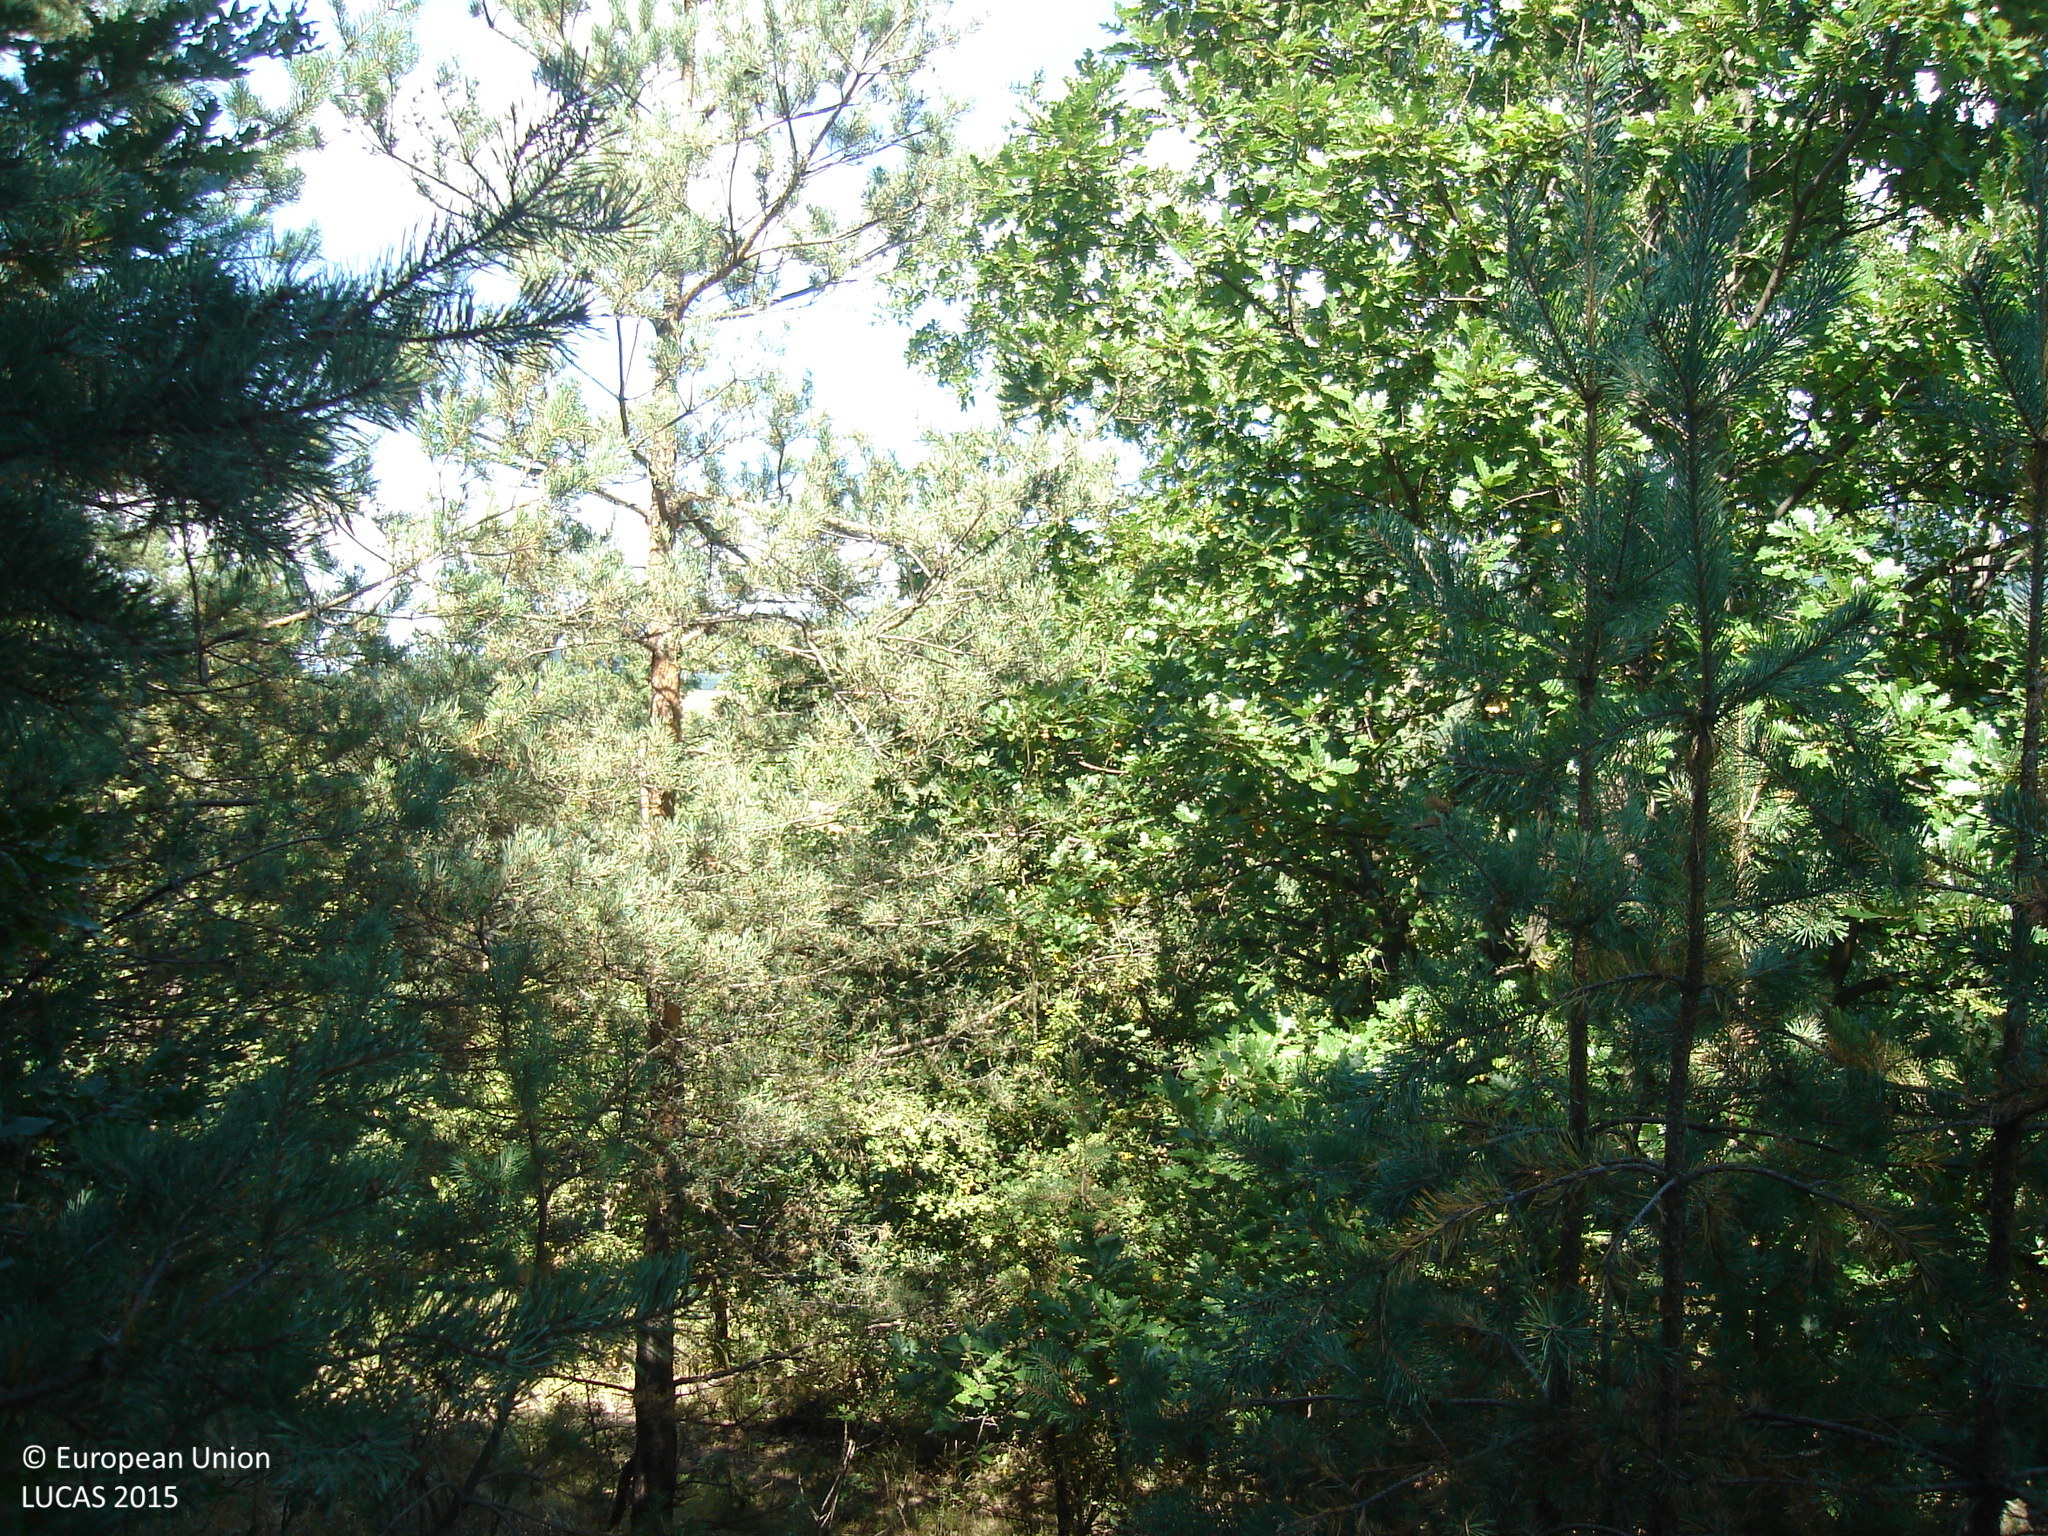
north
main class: Woodland
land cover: Pine dominated mixed woodland
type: hemiboreal forest and nemoral coniferous forest and mixed broadleaved-coniferous forest
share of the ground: > 75 %
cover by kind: coniferous forest trees 55 %, herbaceous plants 25 %, broadleaved forest trees 20 %
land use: Forestry
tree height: > 5 m
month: September
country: BG
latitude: 42.3326
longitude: 23.8864
